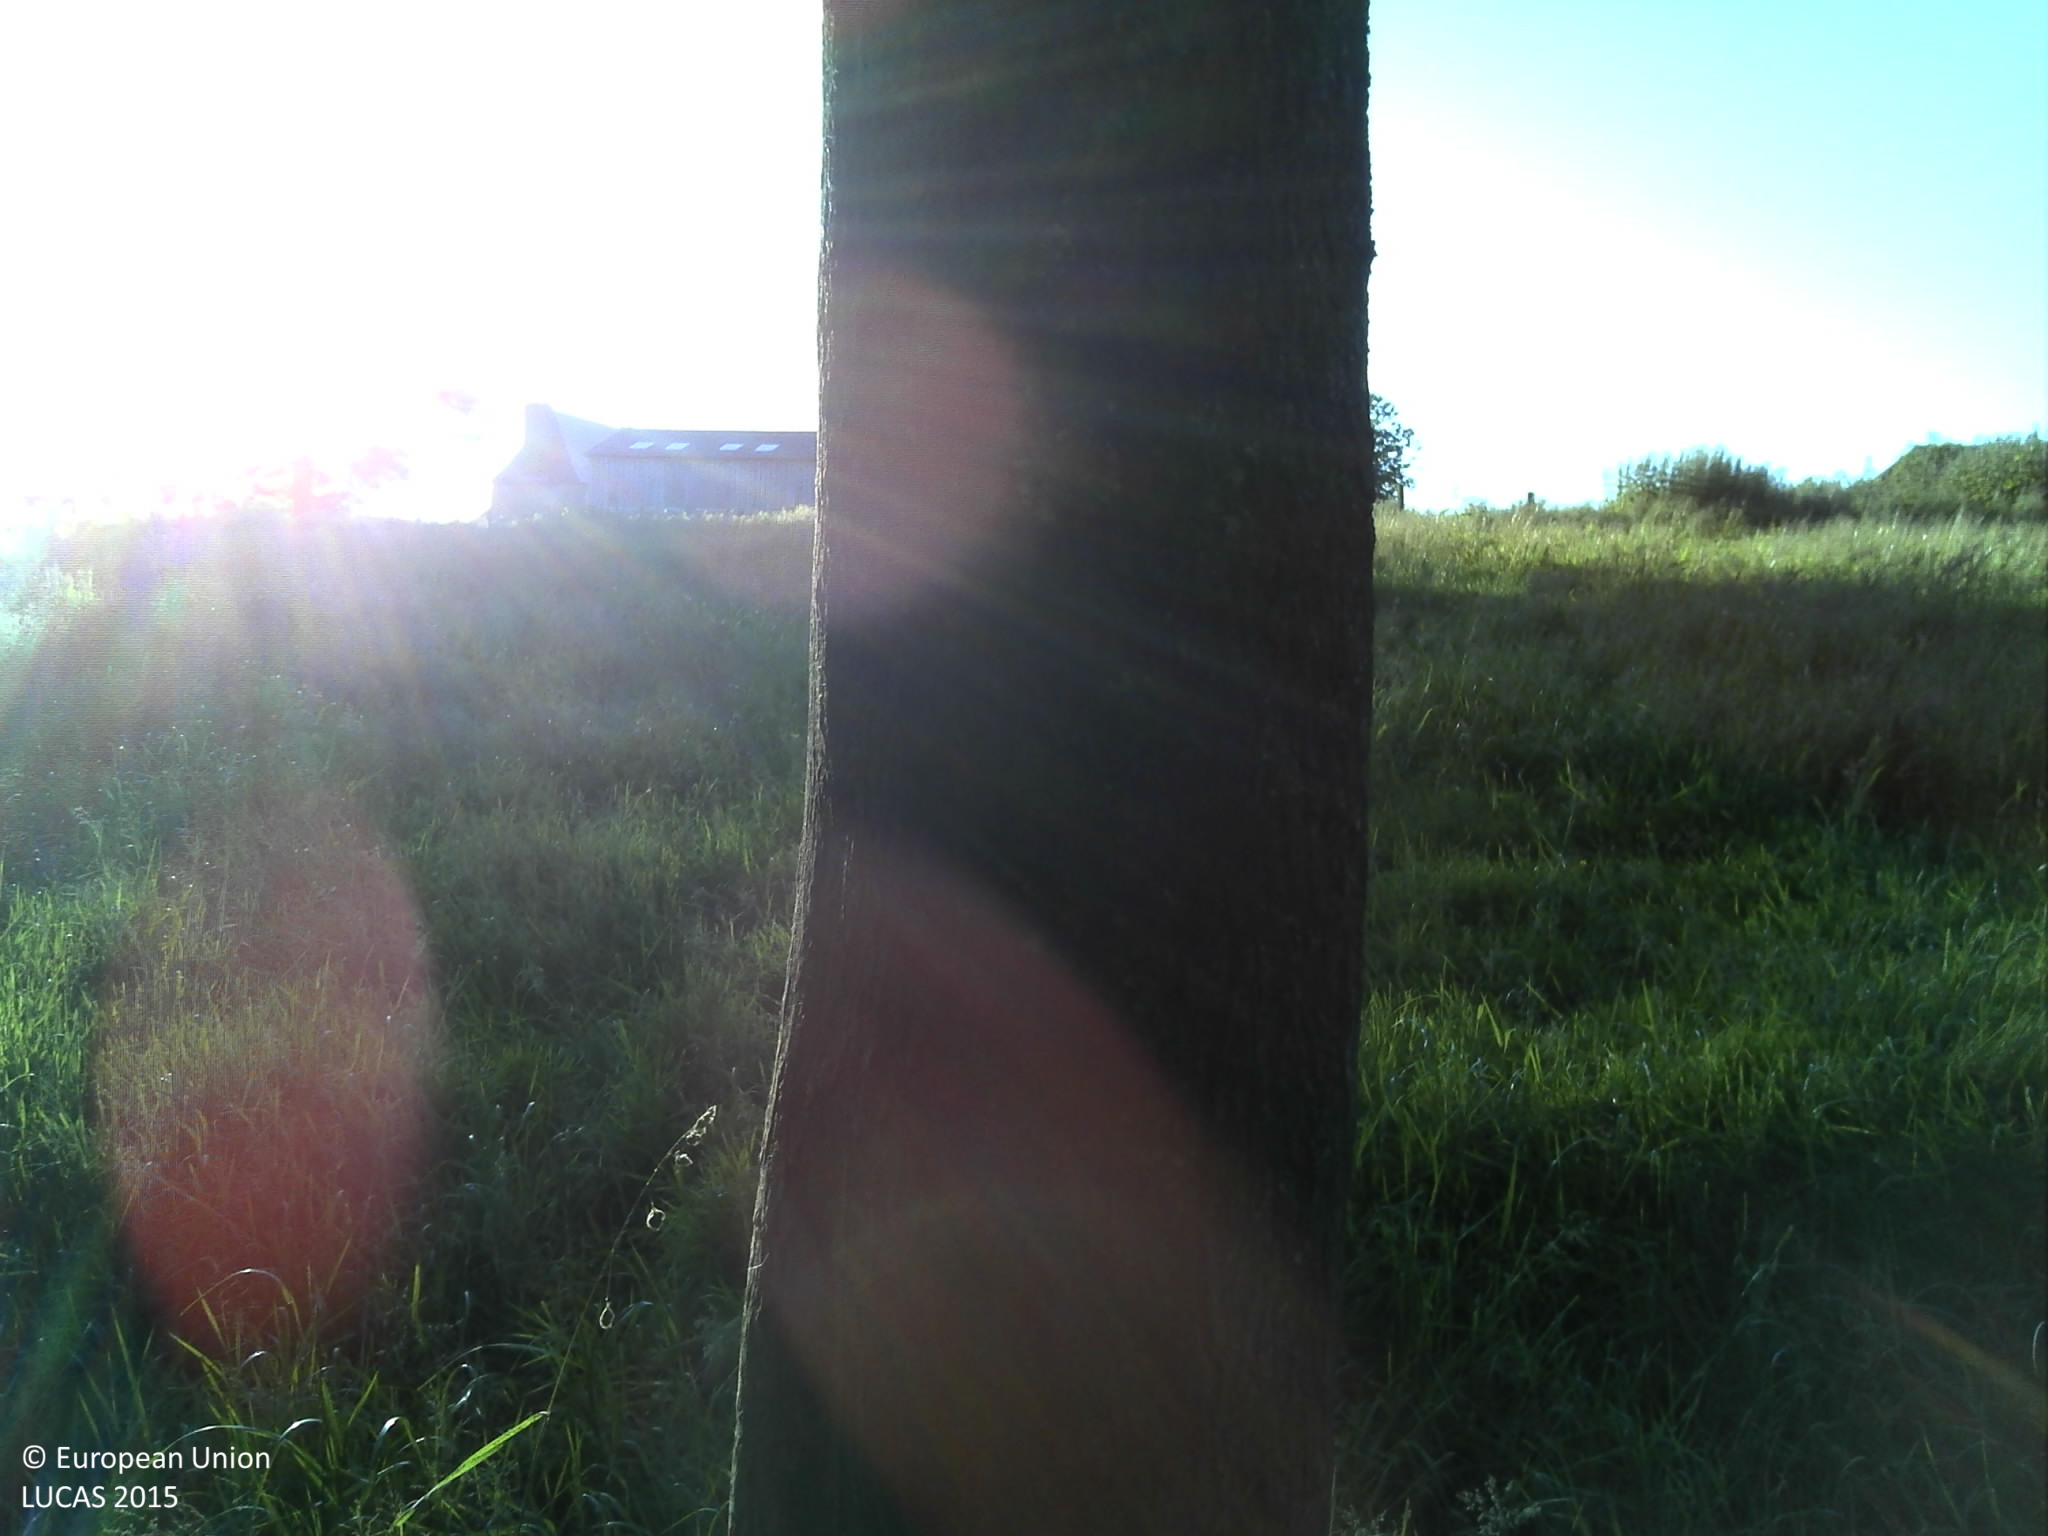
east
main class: Grassland
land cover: Grassland with sparse tree/shrub cover
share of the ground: > 75 %
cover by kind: herbaceous plants 95 %, broadleaved forest trees 5 %
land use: Agriculture (excluding fallow land and kitchen gardens)
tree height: > 5 m
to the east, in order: Grassland with sparse tree/shrub cover; Grassland without tree/shrub cover; Fences; Grassland without tree/shrub cover; Artificial constructions in urban areas; Grassland with sparse tree/shrub cover; Tracks; Grassland with sparse tree/shrub cover; Tracks; Grassland without tree/shrub cover; Fences; Potatoes; Tracks; Other fibre and oleaginous crops
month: June
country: FR
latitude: 49.5902
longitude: 0.9717
